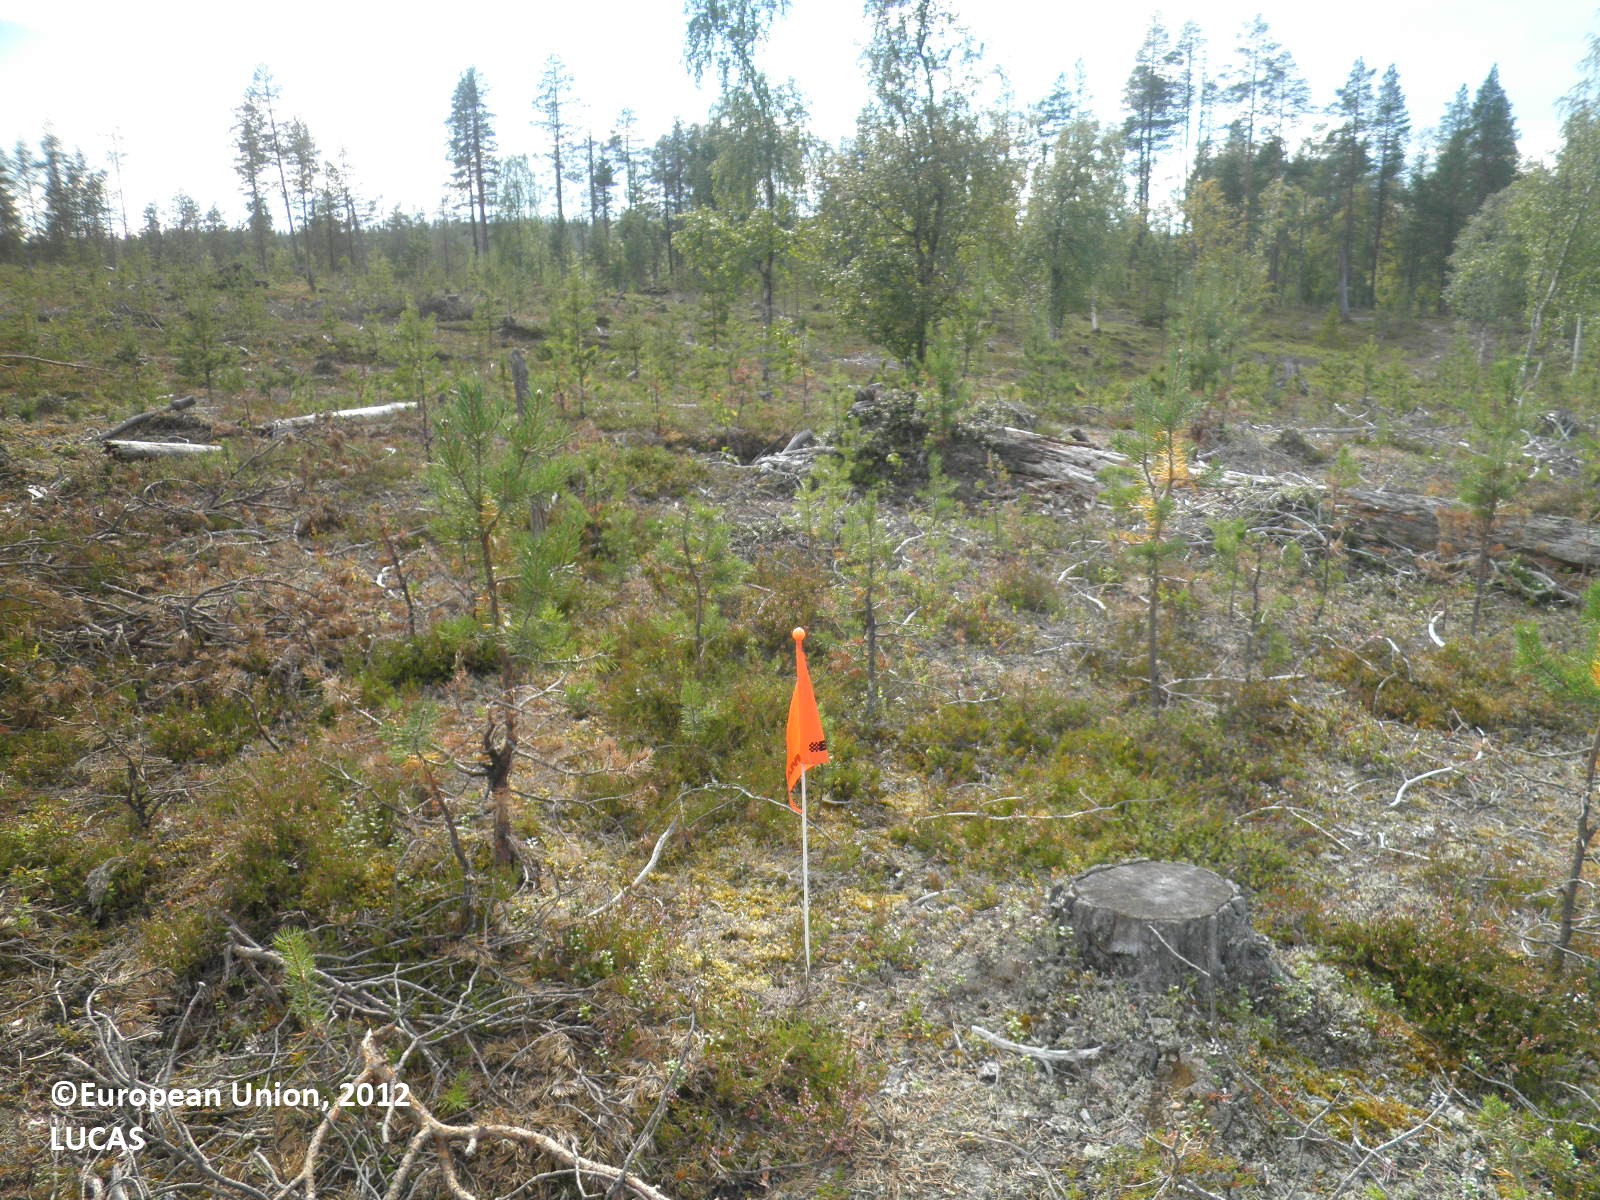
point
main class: Grassland
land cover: Grassland with sparse tree/shrub cover
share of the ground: > 75 %
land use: Forestry
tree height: < 5 m
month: August
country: FI
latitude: 67.4989
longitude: 26.3412
